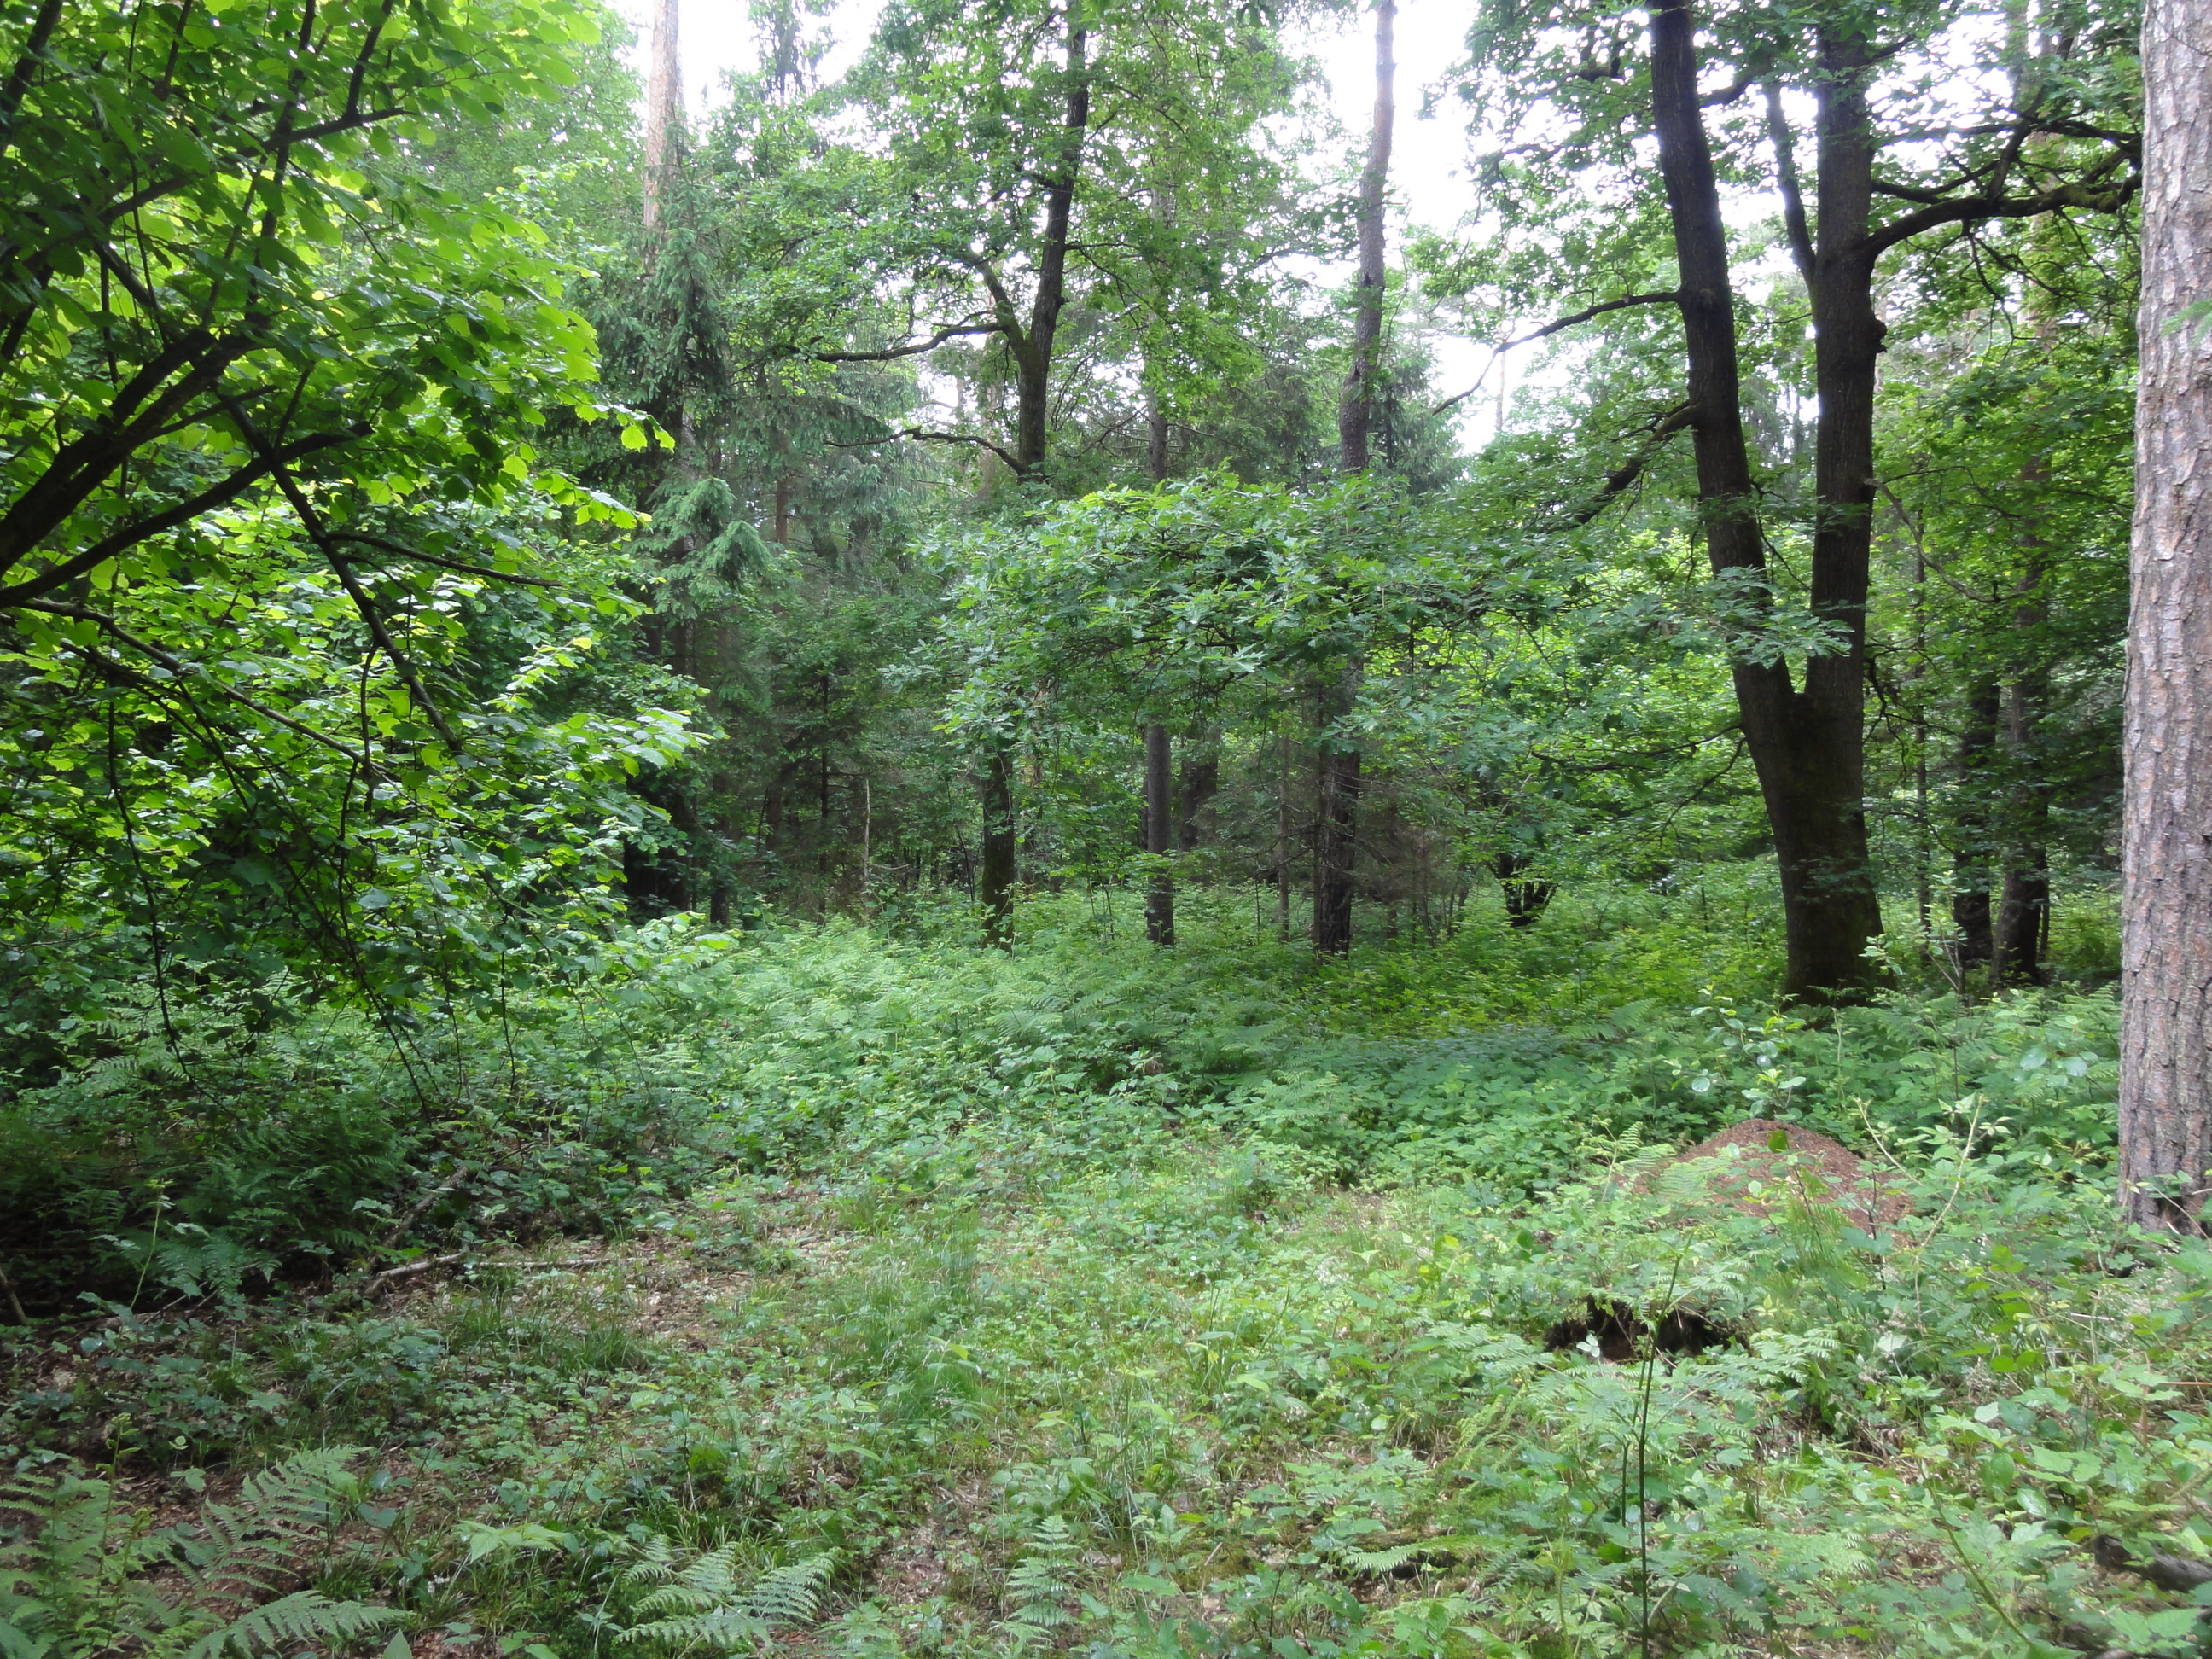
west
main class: Woodland
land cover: Other mixed woodland
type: hemiboreal forest and nemoral coniferous forest and mixed broadleaved-coniferous forest
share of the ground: > 75 %
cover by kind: coniferous forest trees 70 %, broadleaved forest trees 25 %, herbaceous plants 5 %
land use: Forestry
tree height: > 5 m
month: May
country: SI
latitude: 46.4871
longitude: 15.7180
